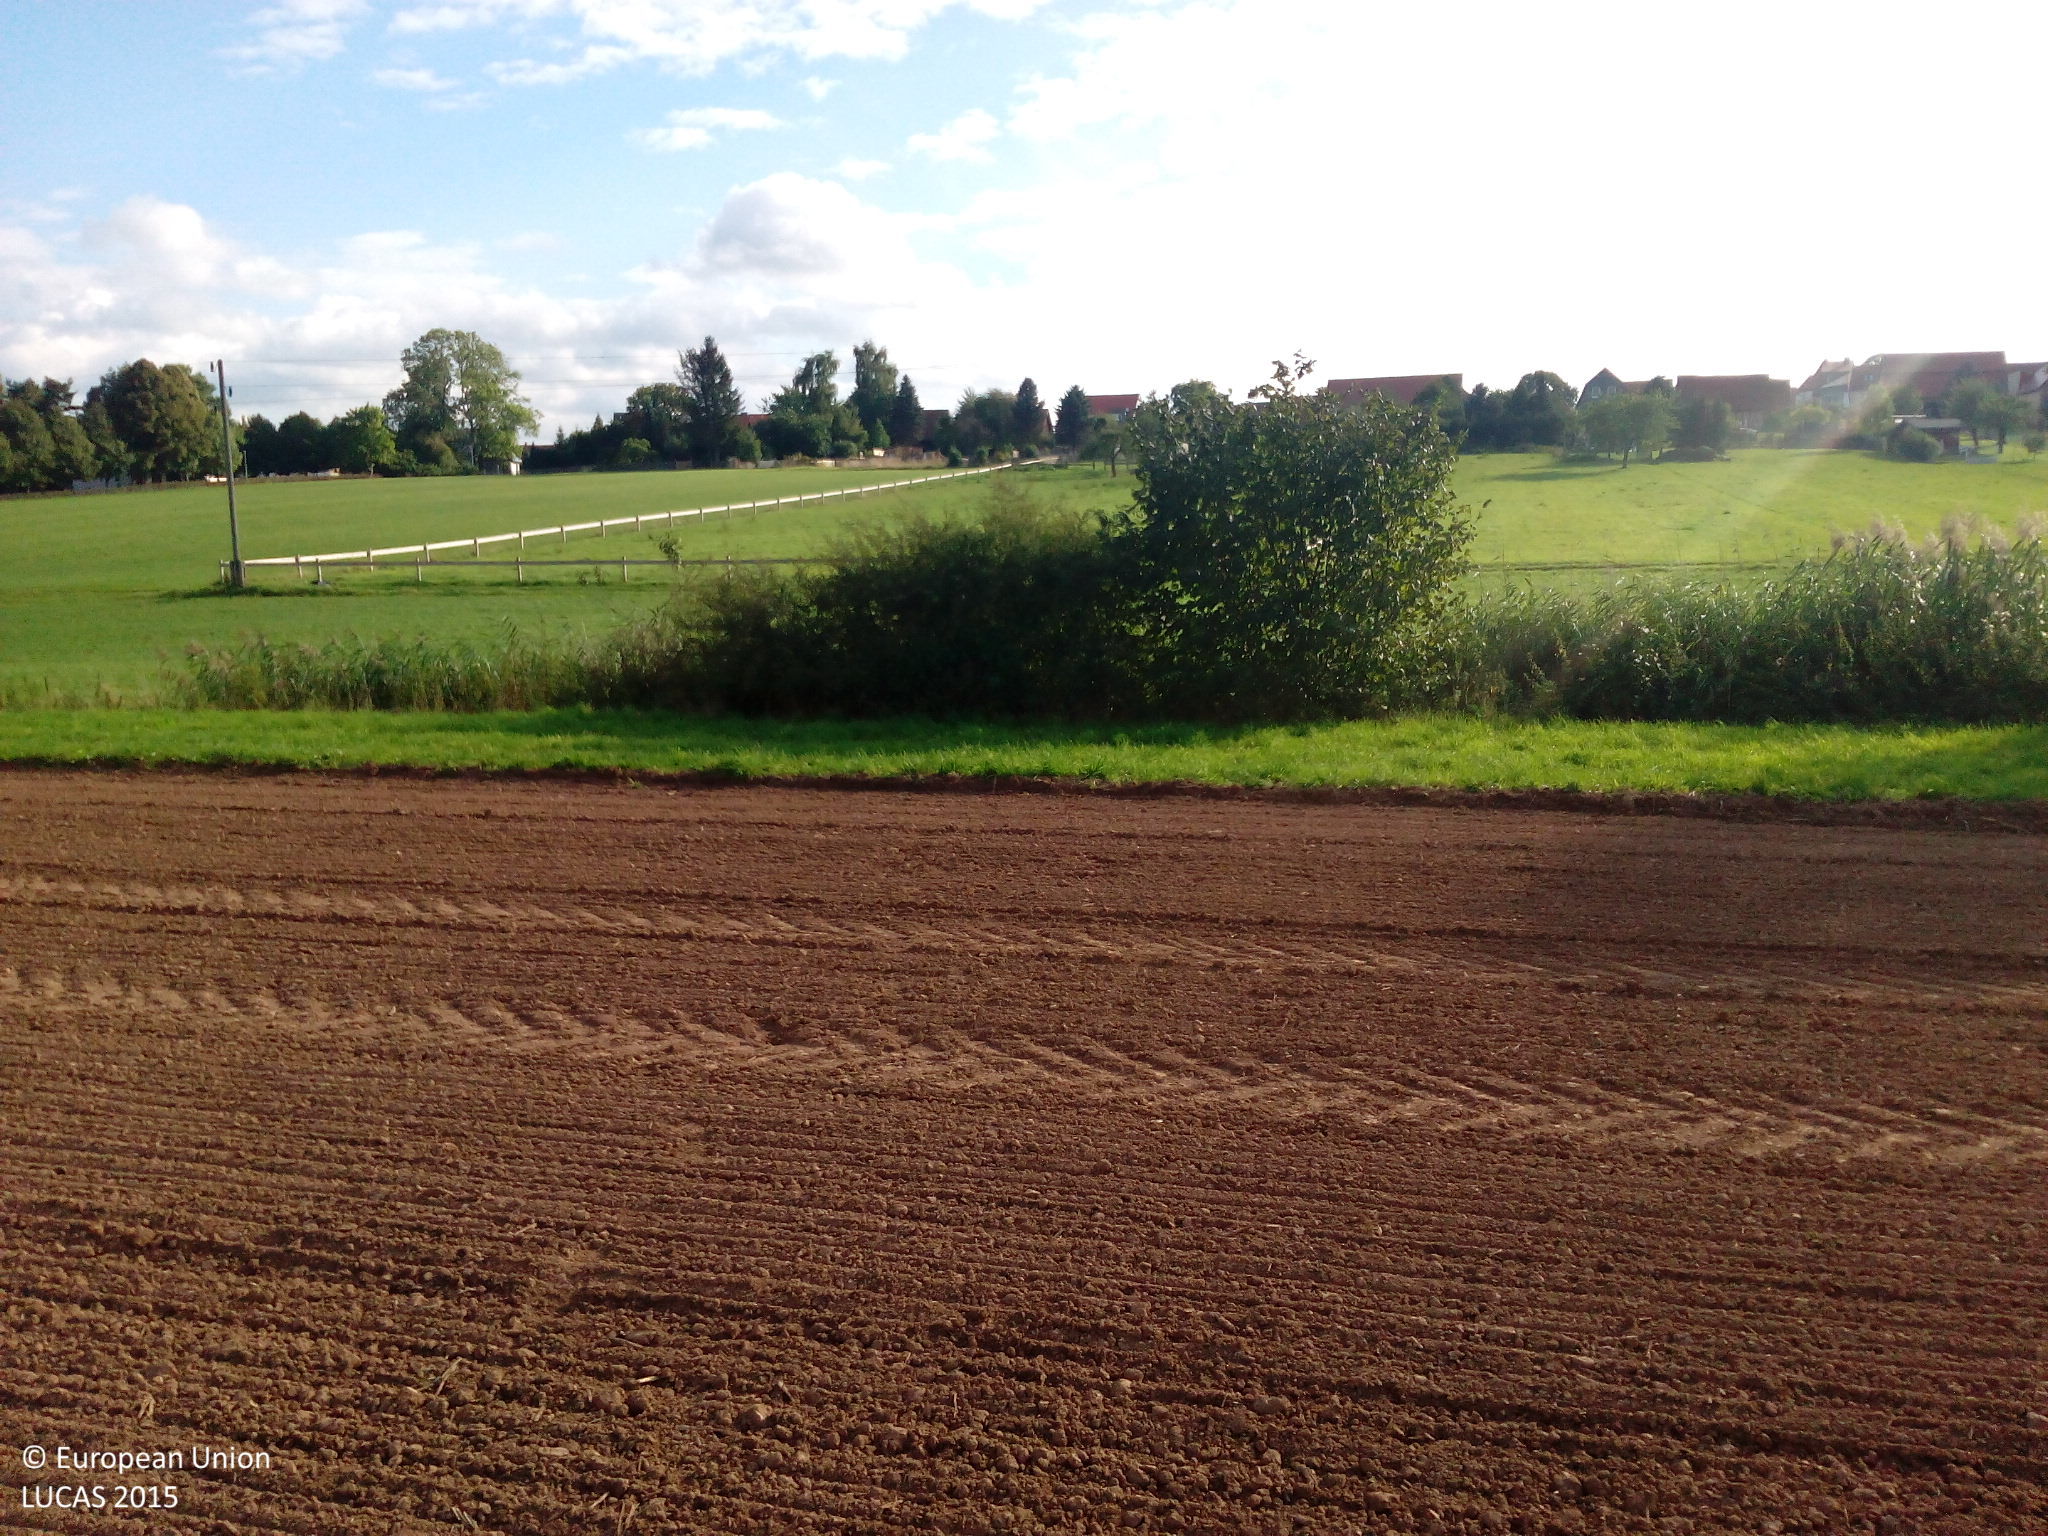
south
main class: Cropland
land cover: Common wheat
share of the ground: < 10 %
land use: Agriculture (excluding fallow land and kitchen gardens)
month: September
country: DE
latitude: 51.3883
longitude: 10.3591
